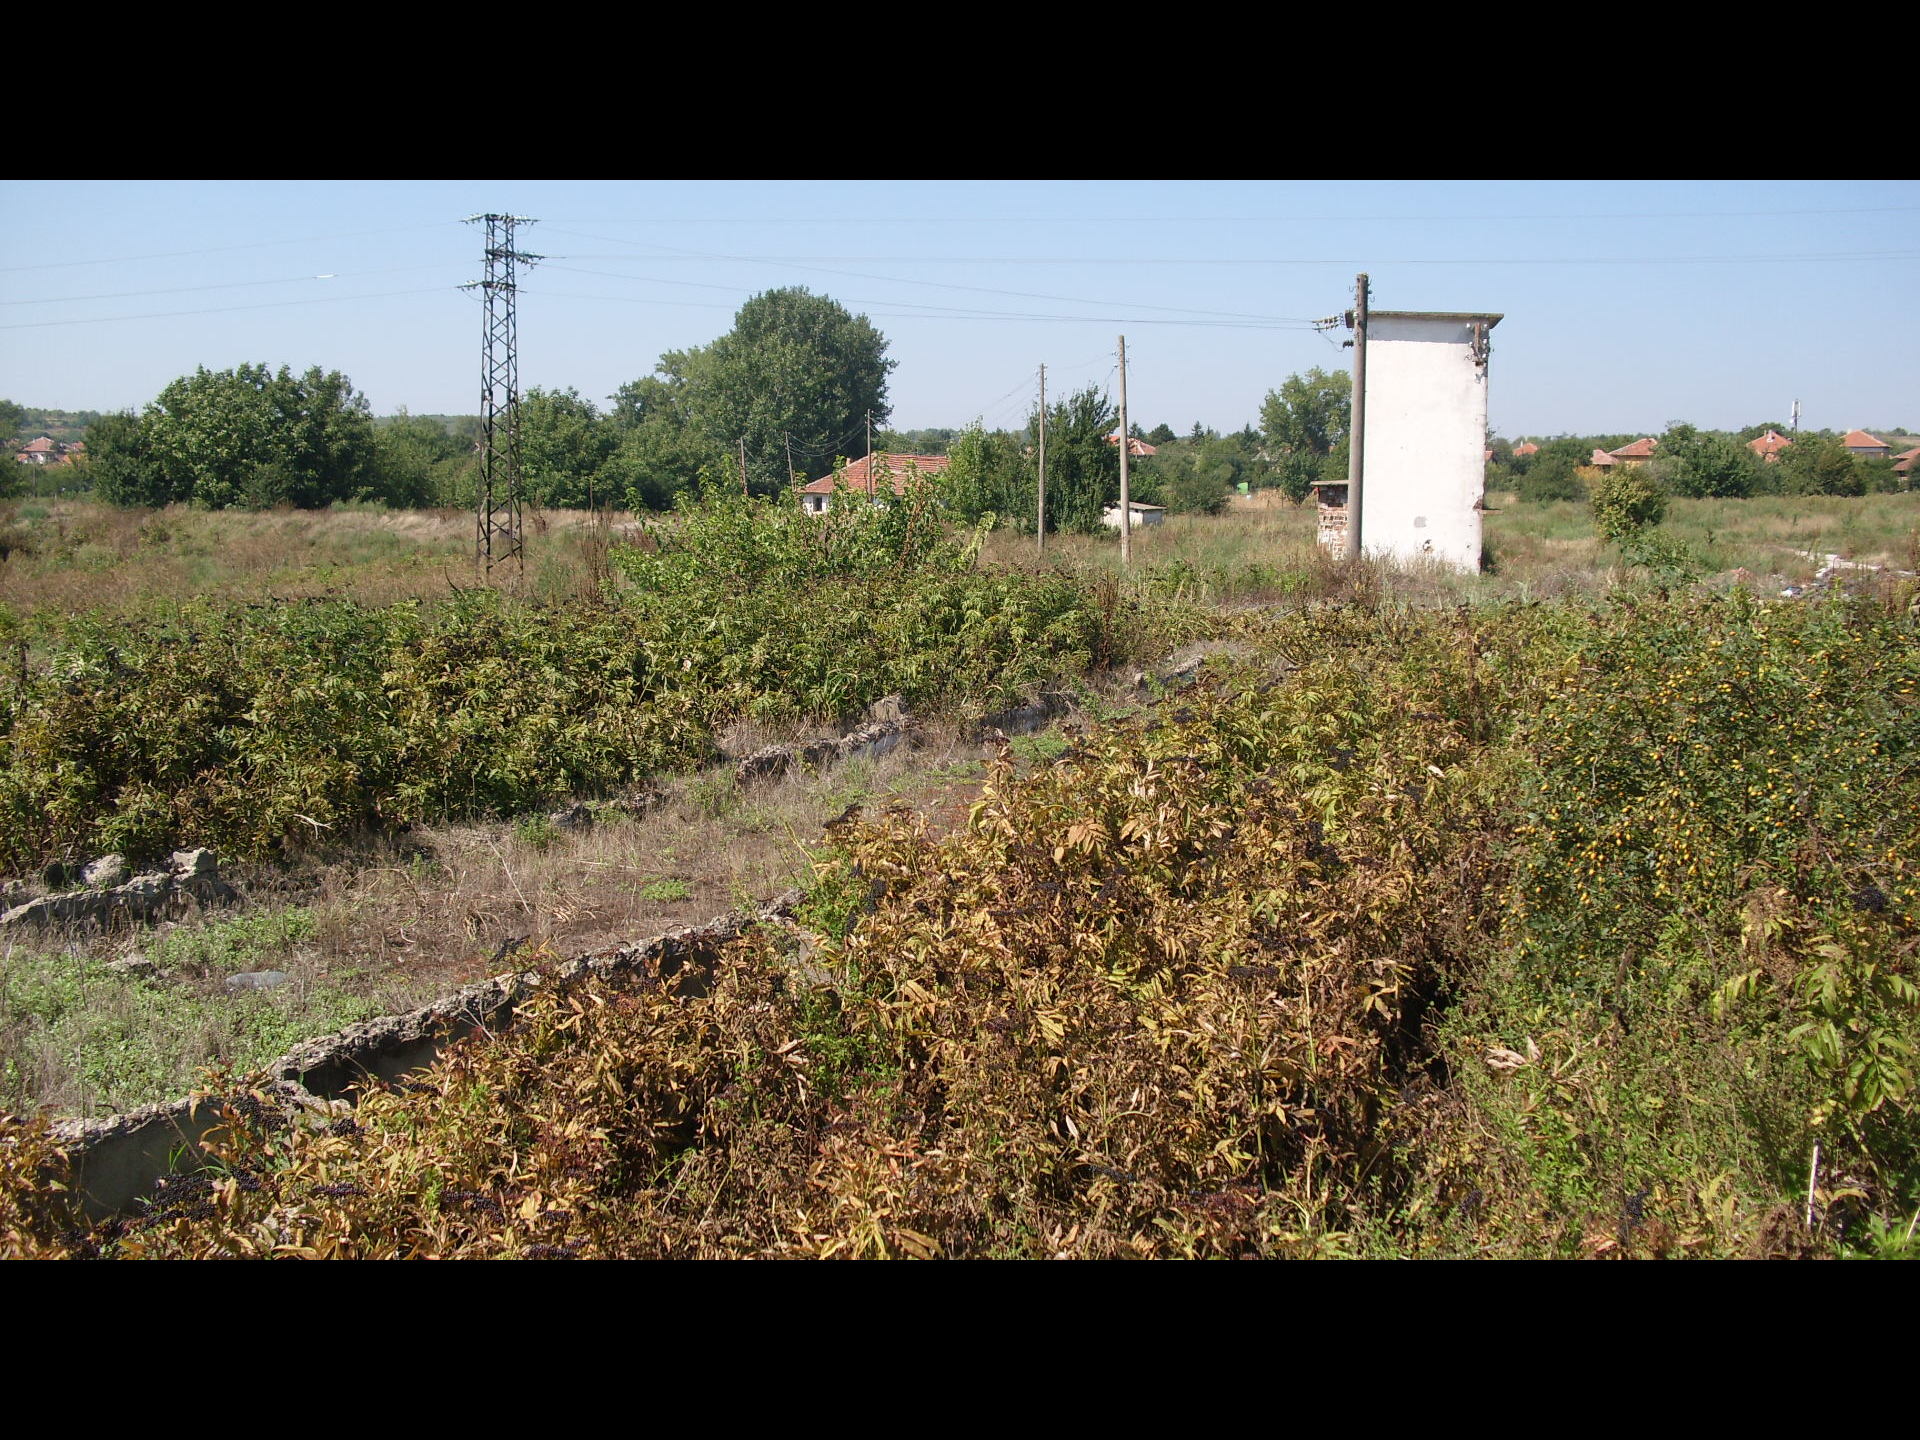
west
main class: Grassland
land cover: Grassland with sparse tree/shrub cover
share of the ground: > 75 %
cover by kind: herbaceous plants 85 %, shrubs 10 %, broadleaved forest trees 5 %
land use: Abandoned areas
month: August
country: BG
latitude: 44.0930
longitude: 22.8679
